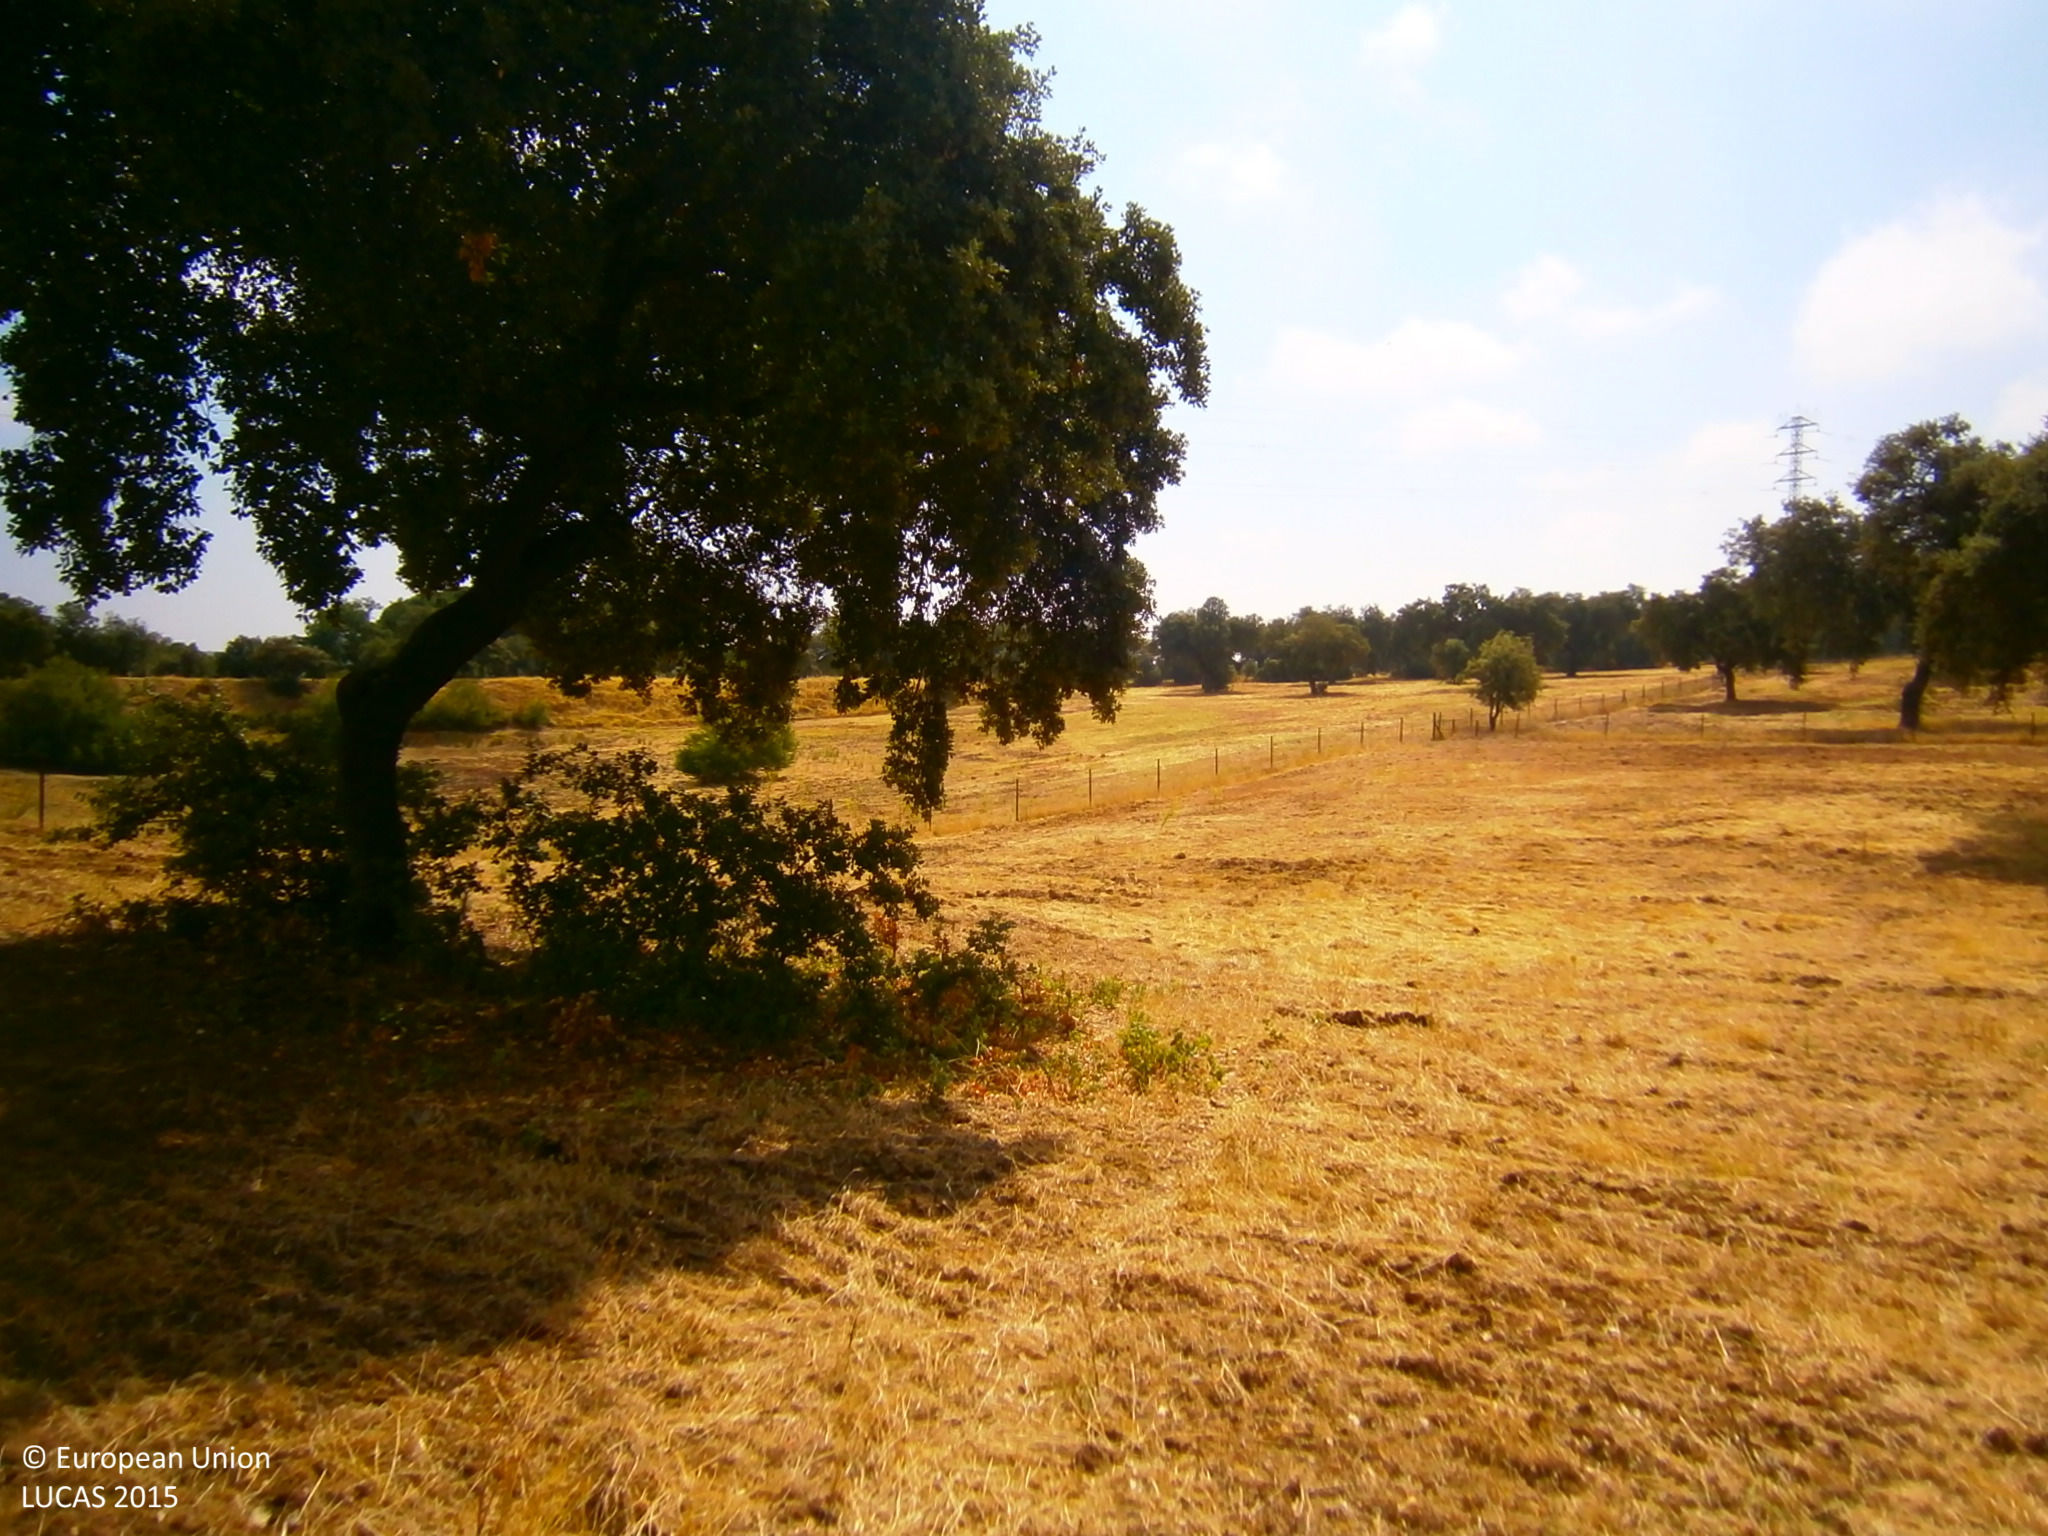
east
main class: Woodland
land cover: Broadleaved woodland
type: broadleaved evergreen forest
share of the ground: > 75 %
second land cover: Spontaneously vegetated surfaces
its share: > 75 %
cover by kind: herbaceous plants 70 %, broadleaved forest trees 20 %, shrubs 5 %, unconsolidated bare surface 5 %
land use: Forestry
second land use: Agriculture (excluding fallow land and kitchen gardens)
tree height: > 5 m
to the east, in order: Broadleaved woodland; Spontaneously vegetated surfaces; Grassland with sparse tree/shrub cover; Fences; Broadleaved woodland; Fences; Broadleaved woodland; Tracks; Fences; Pine dominated coniferous woodland
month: July
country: ES
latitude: 38.7579
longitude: -6.9723
